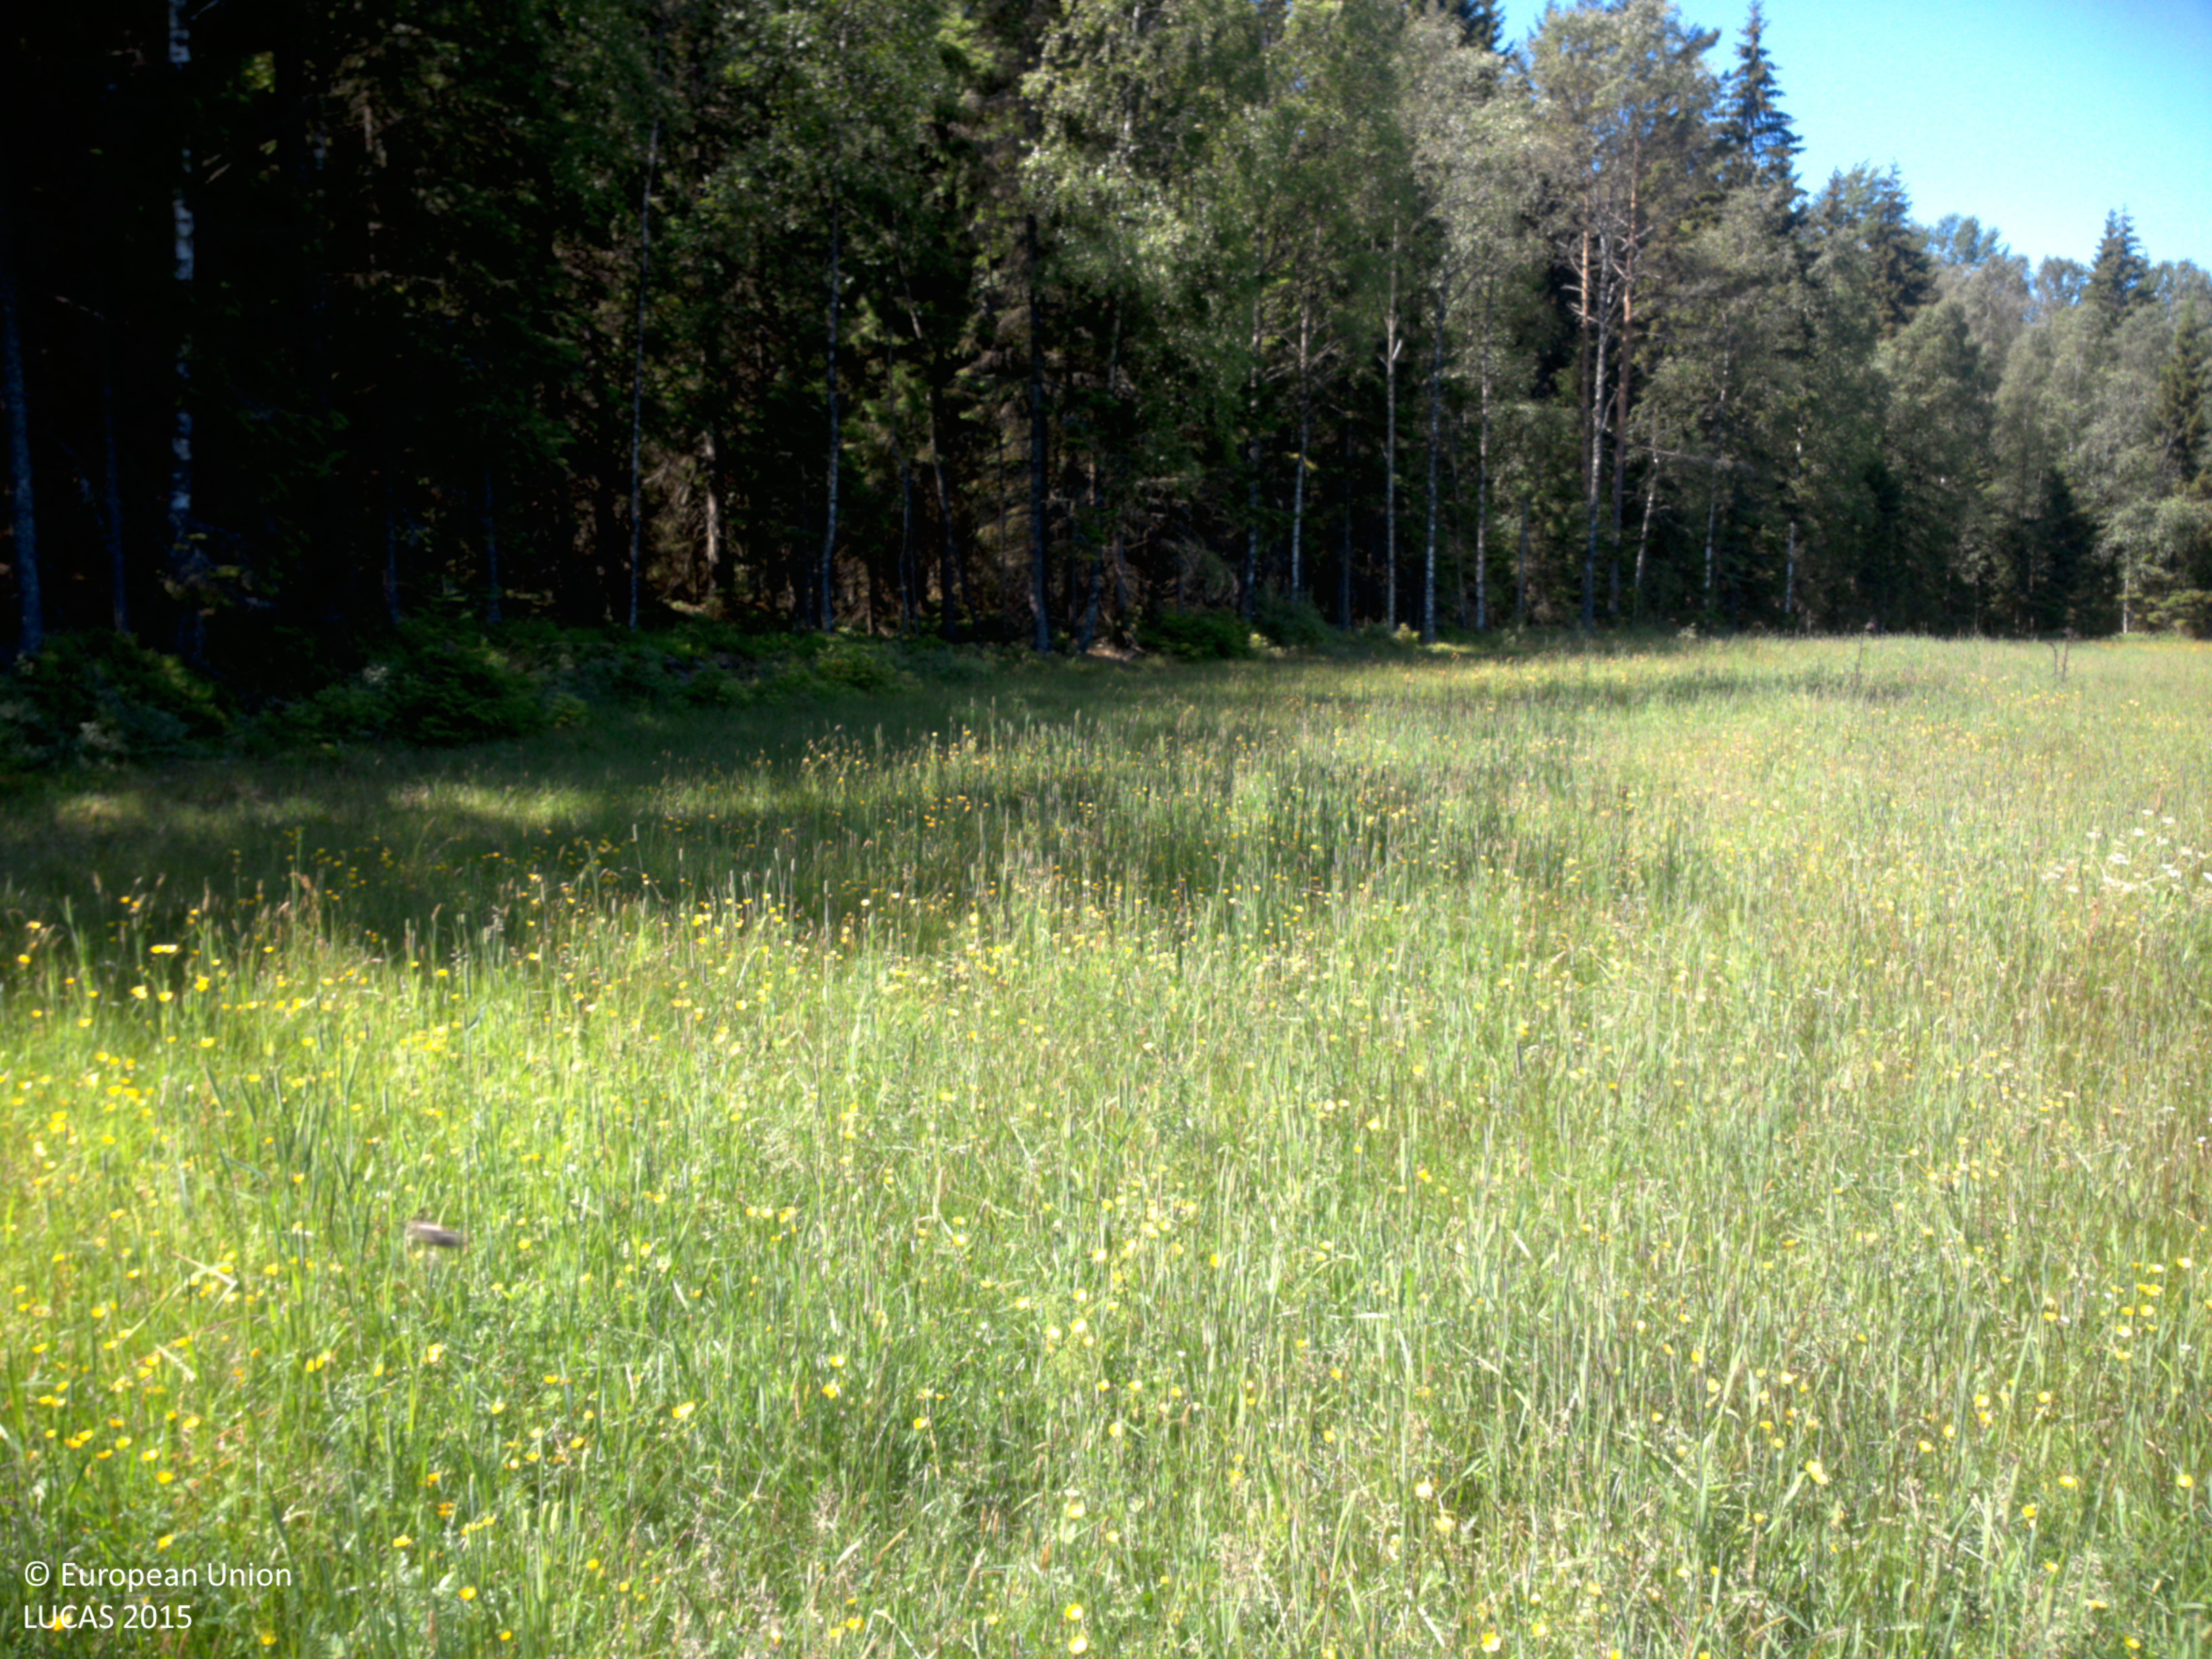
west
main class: Grassland
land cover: Grassland without tree/shrub cover
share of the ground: > 75 %
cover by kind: herbaceous plants 100 %
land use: Agriculture (excluding fallow land and kitchen gardens)
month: July
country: SE
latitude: 58.7965
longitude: 12.1239
